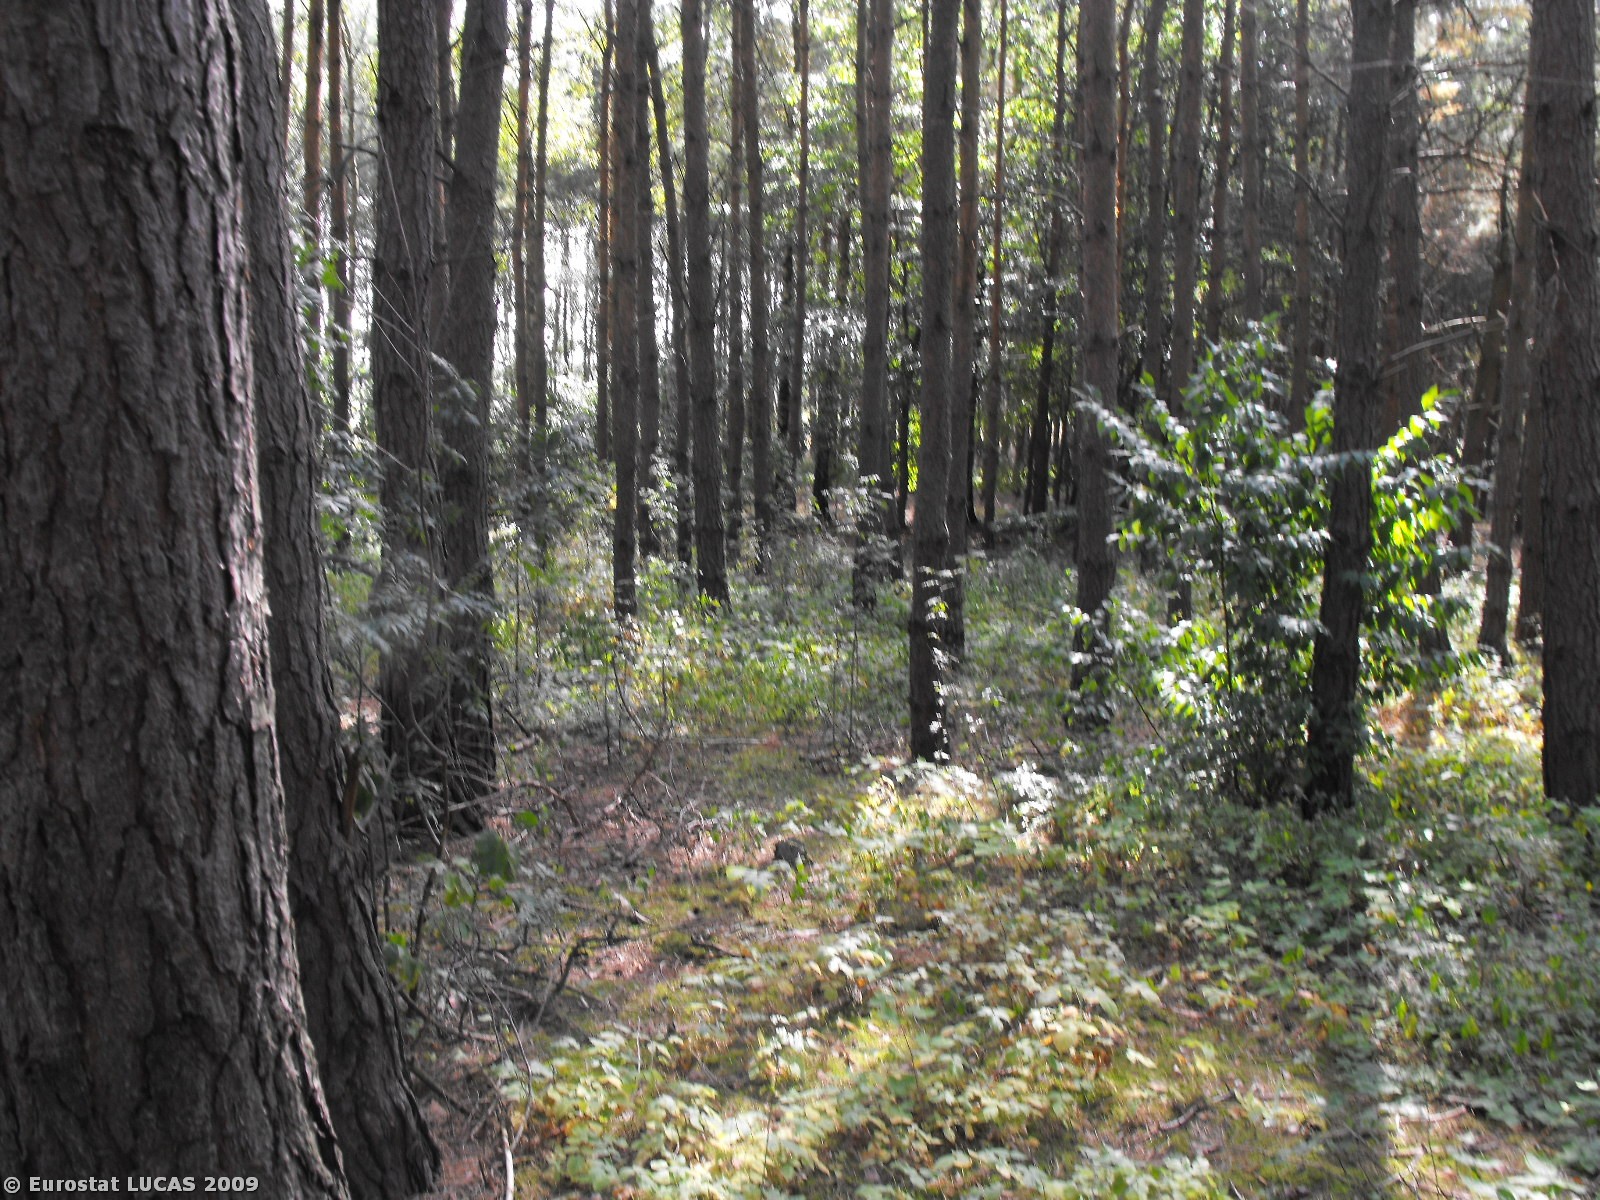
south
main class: Woodland
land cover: Mixed woodland
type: hemiboreal forest and nemoral coniferous forest and mixed broadleaved-coniferous forest
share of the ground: > 75 %
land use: Forestry
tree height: > 5 m
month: August
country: PL
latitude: 52.8488
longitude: 16.4962
